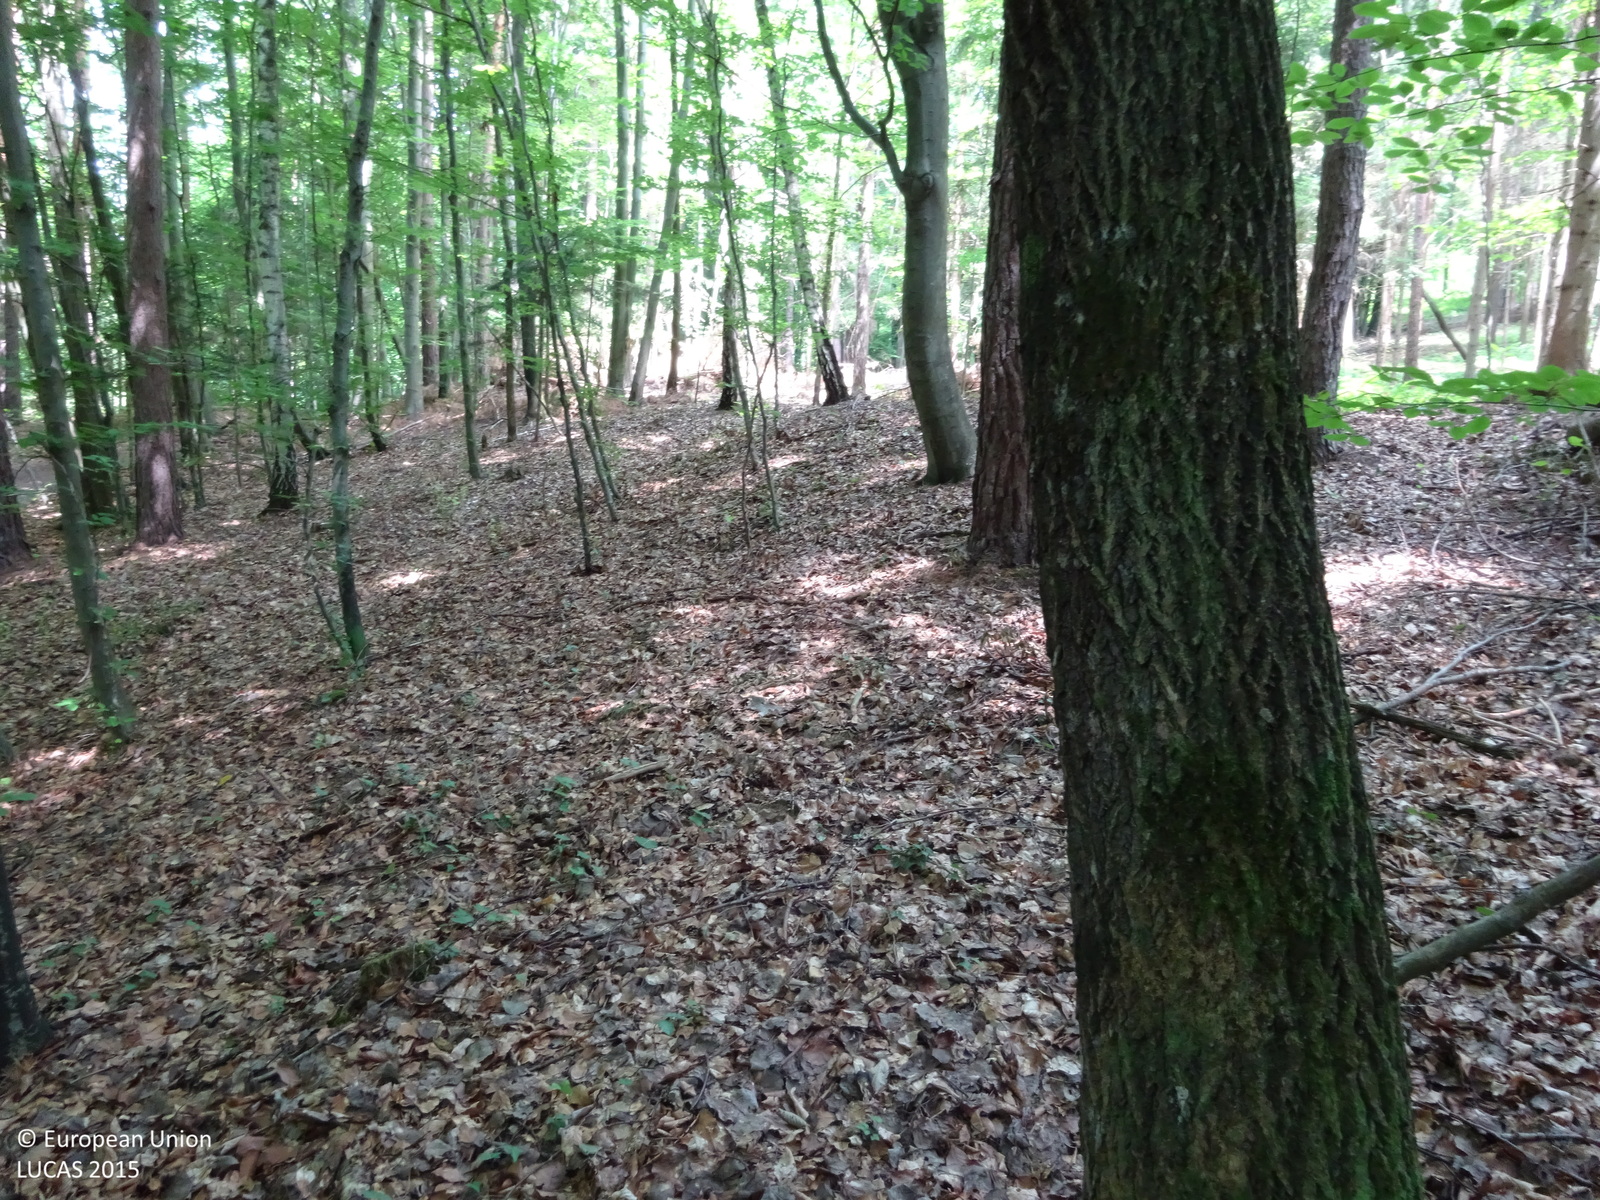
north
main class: Woodland
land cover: Pine dominated mixed woodland
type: hemiboreal forest and nemoral coniferous forest and mixed broadleaved-coniferous forest
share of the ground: > 75 %
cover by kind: broadleaved forest trees 75 %, coniferous forest trees 25 %
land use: Forestry
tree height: > 5 m
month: June
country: AT
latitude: 46.8541
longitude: 15.9418
